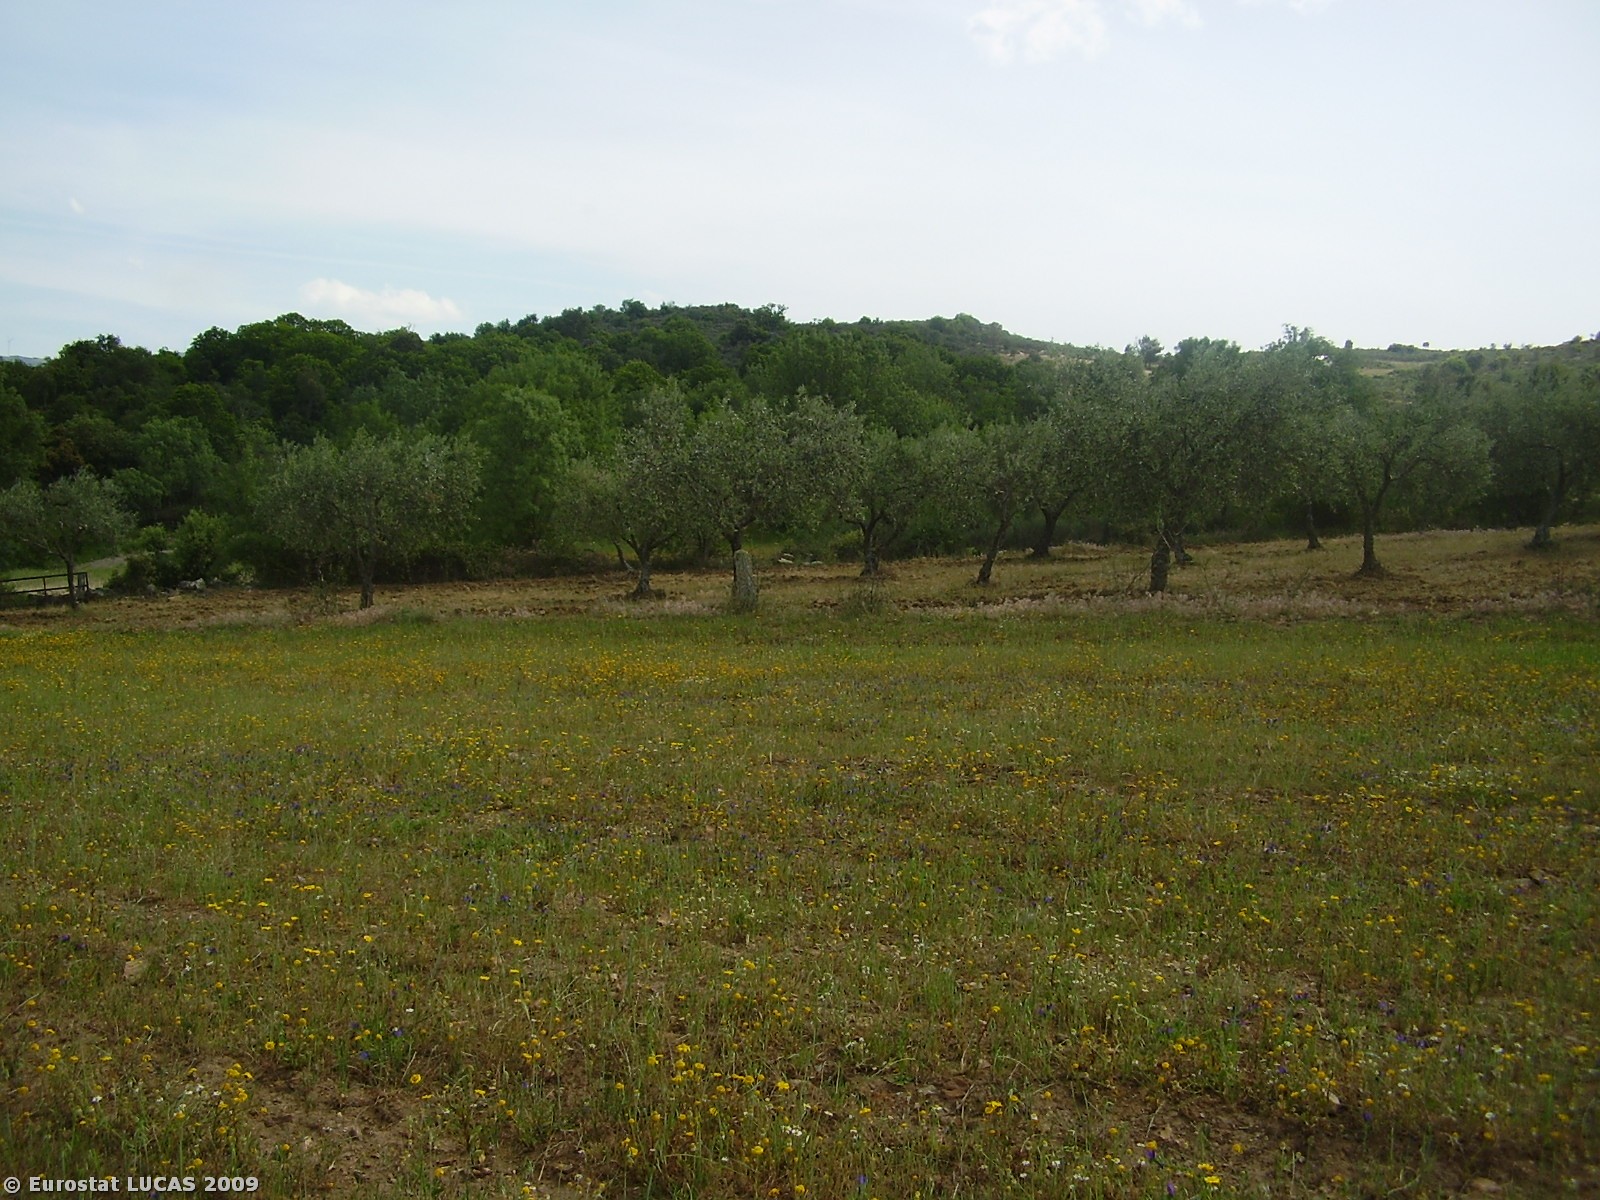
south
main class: Cropland
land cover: Mixed cereals for fodder
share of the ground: 50 - 75 %
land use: Agriculture (excluding fallow land and kitchen gardens)
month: May
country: PT
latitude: 41.5097
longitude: -7.0453
